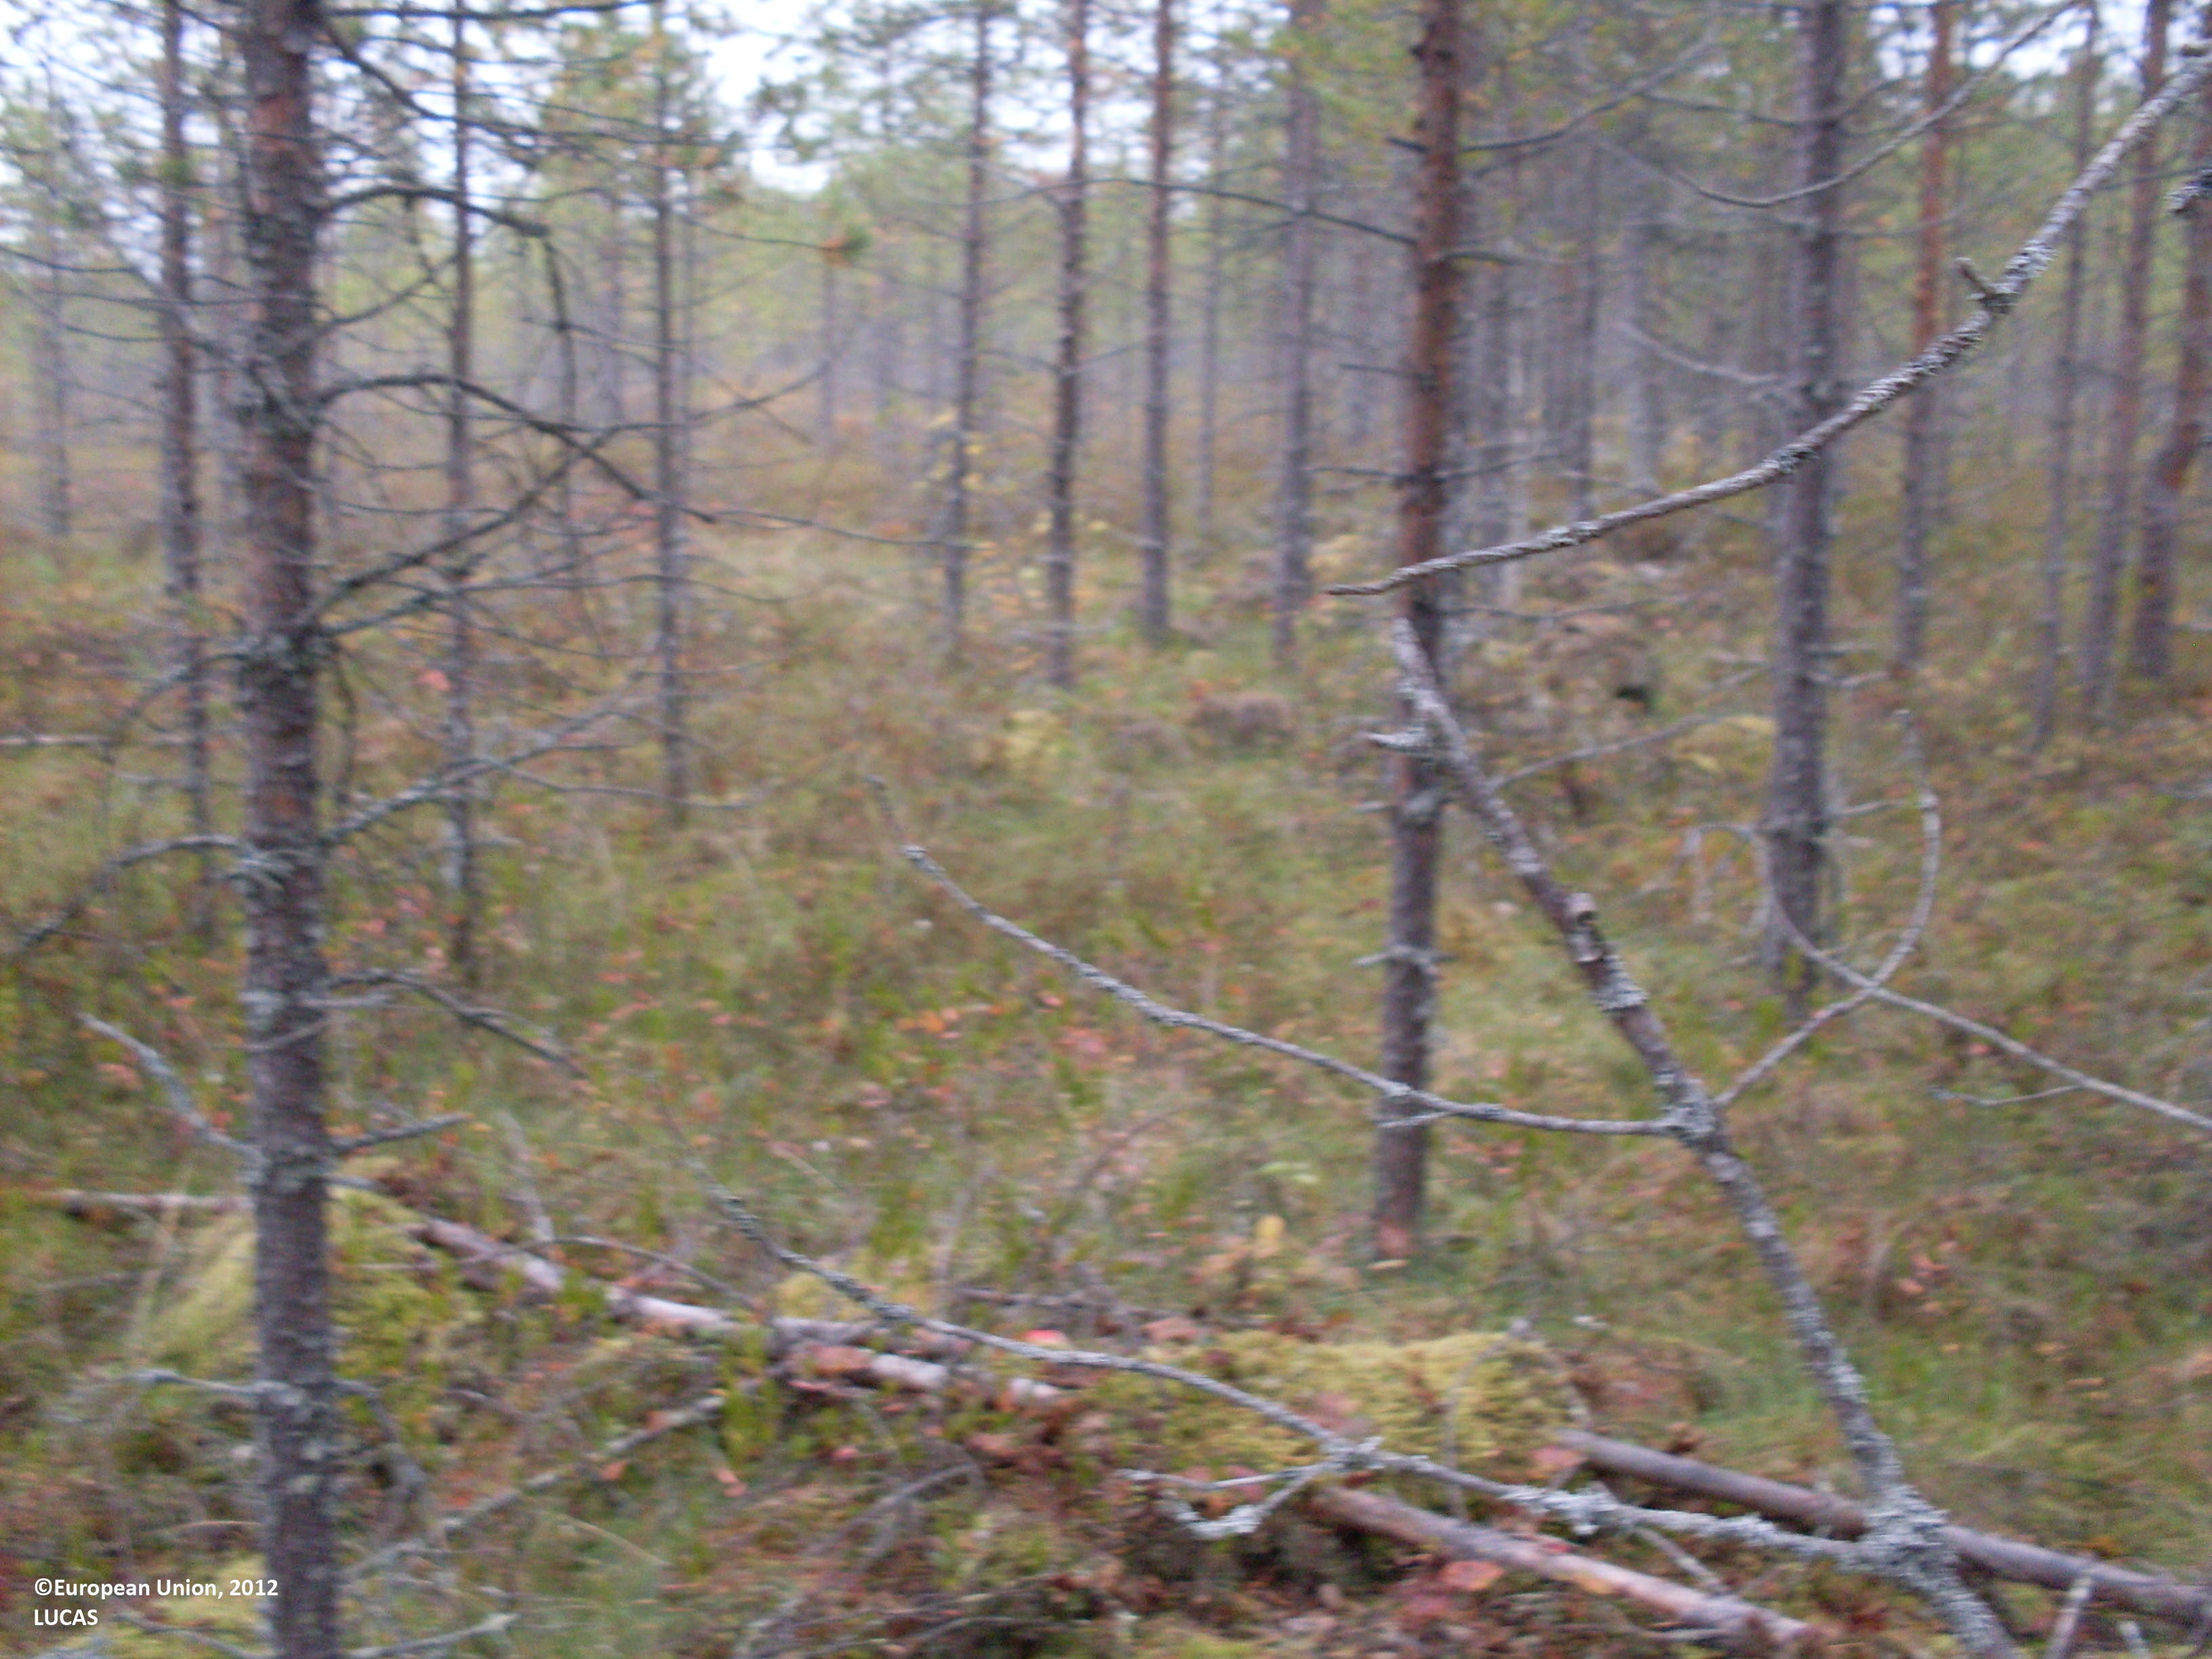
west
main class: Woodland
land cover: Pine dominated coniferous woodland
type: boreal forest
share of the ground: 50 - 75 %
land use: Forestry
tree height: > 5 m
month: September
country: FI
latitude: 64.1504
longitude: 29.4360
